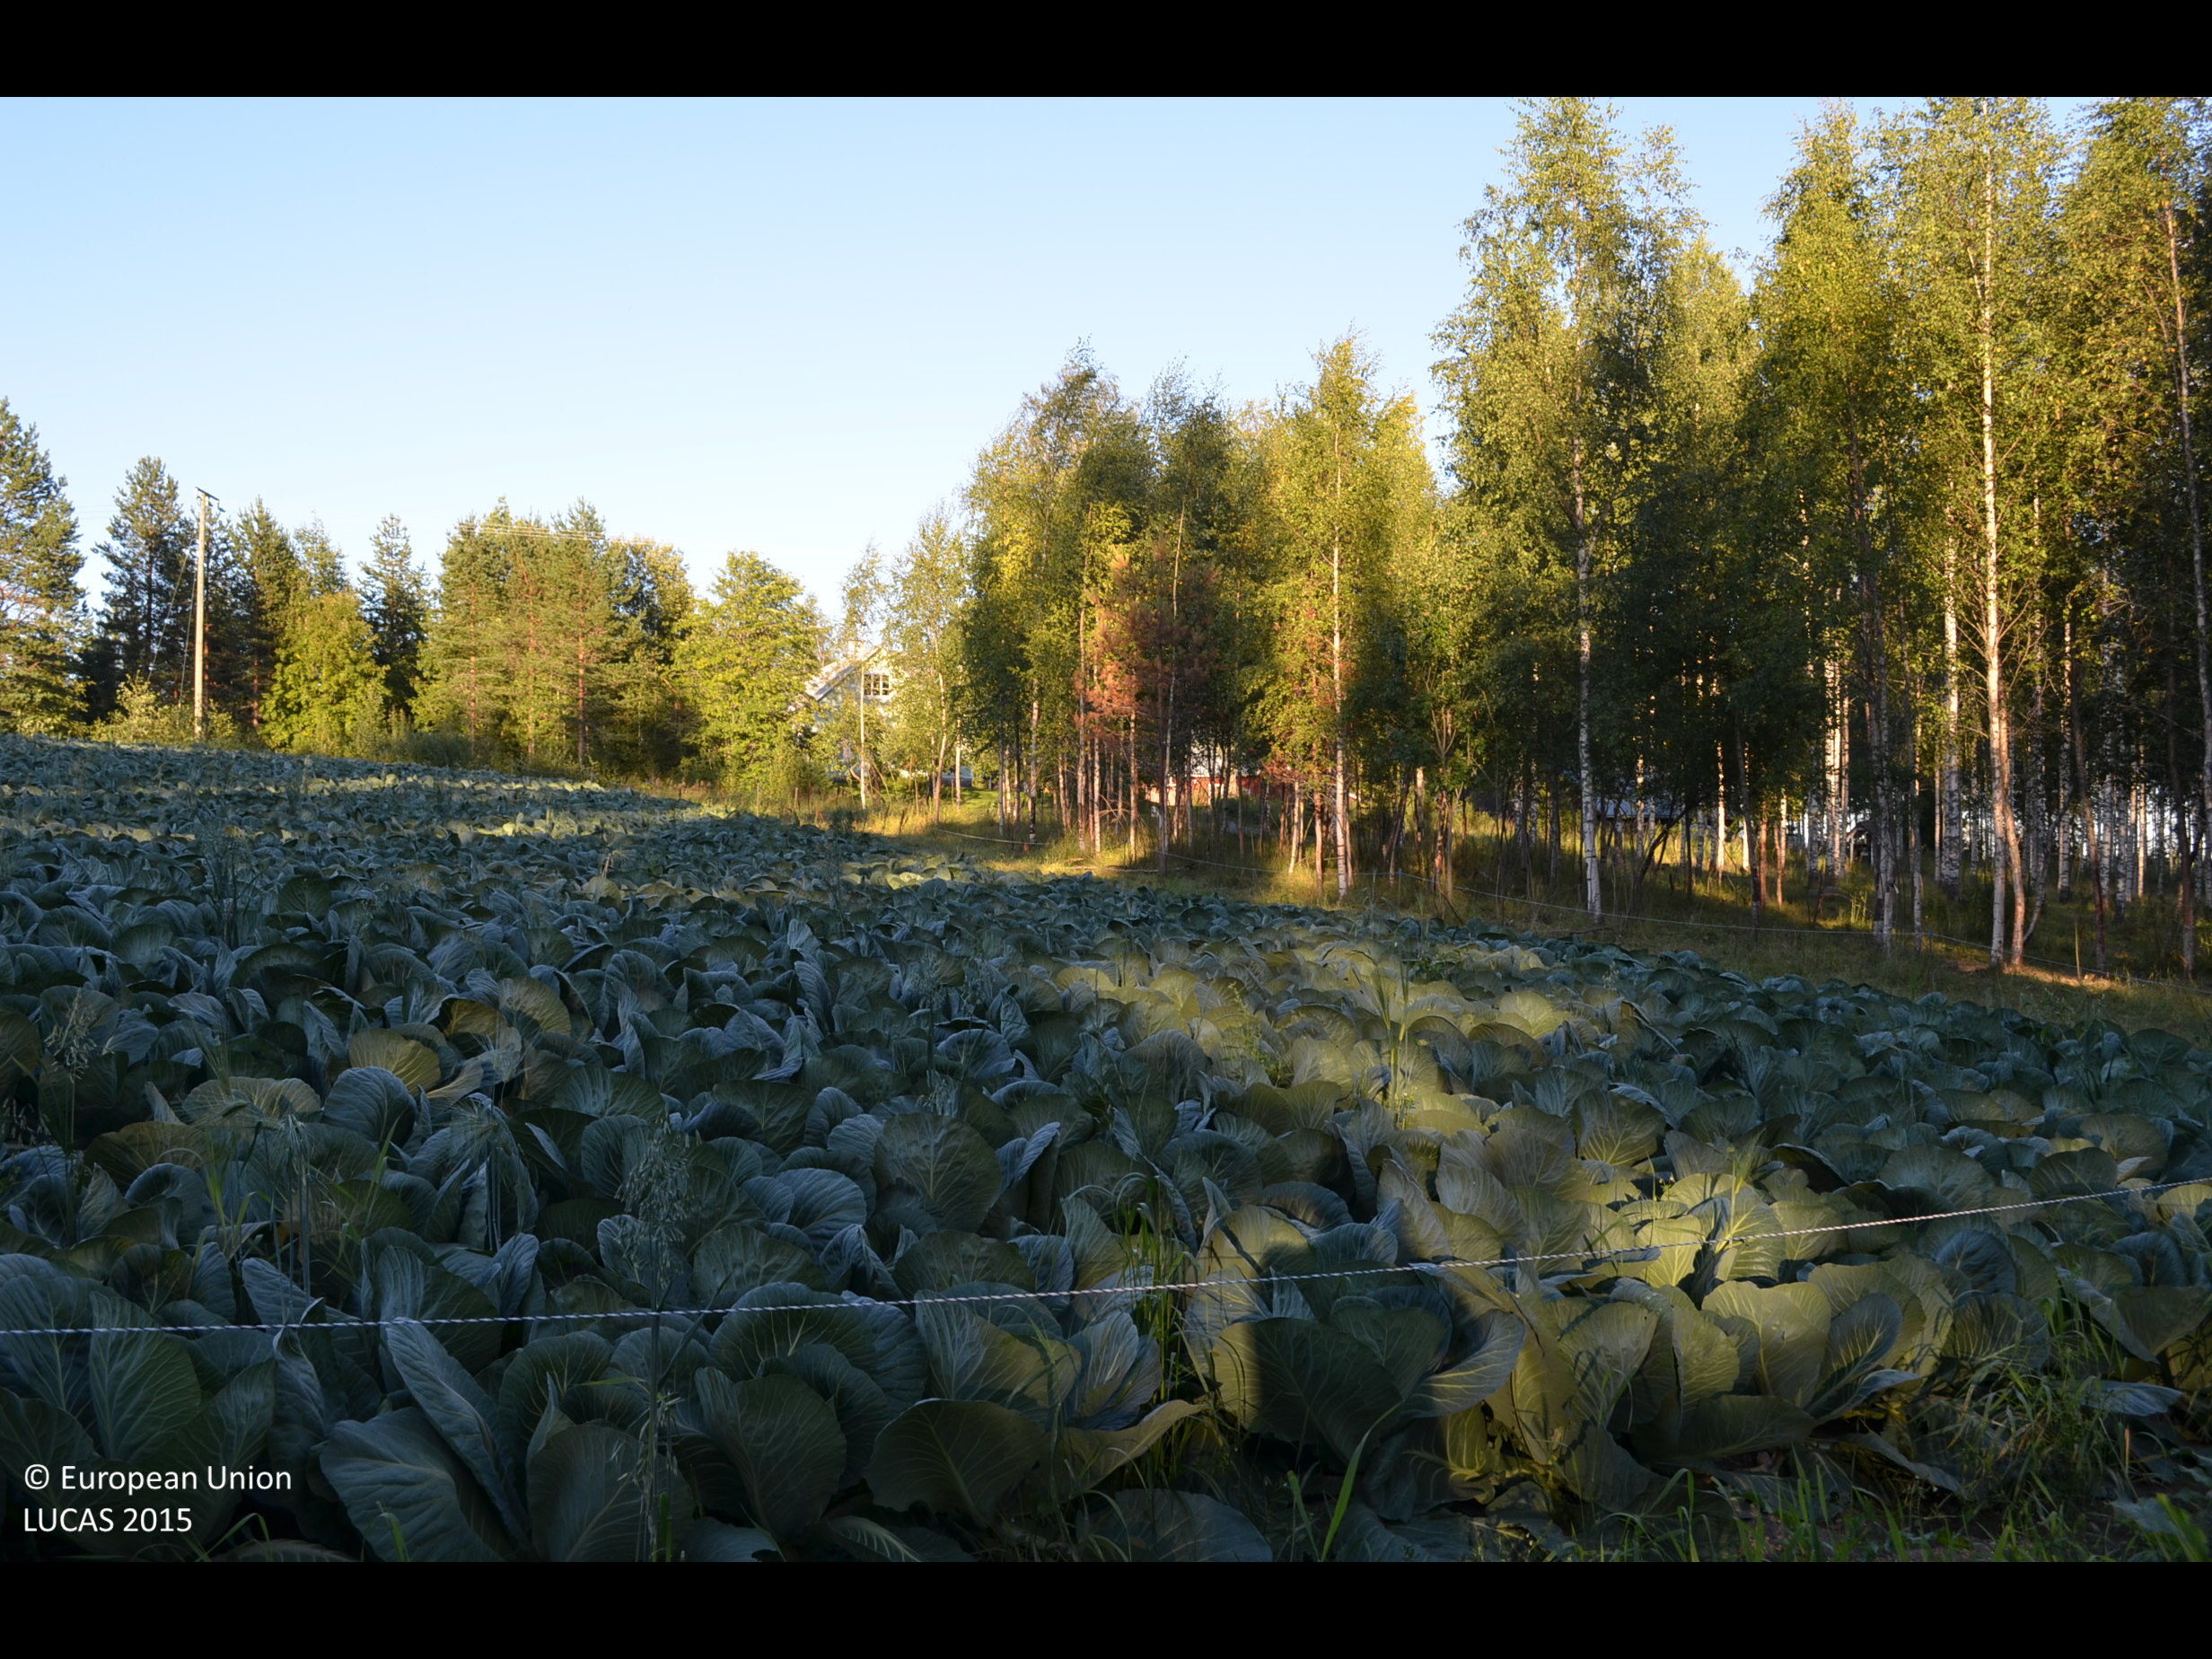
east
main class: Cropland
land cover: Temporary grasslands
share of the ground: > 75 %
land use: Agriculture (excluding fallow land and kitchen gardens)
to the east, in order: Temporary grasslands; Fences; Other fresh vegetables; Fences; Grass margins; Tracks; Ditches and canals; Electric lines; Pine dominated mixed woodland; Artificial constructions in urban areas; Other coniferous woodland; Spruce dominated mixed woodland
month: August
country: FI
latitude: 62.3068
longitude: 24.3421
